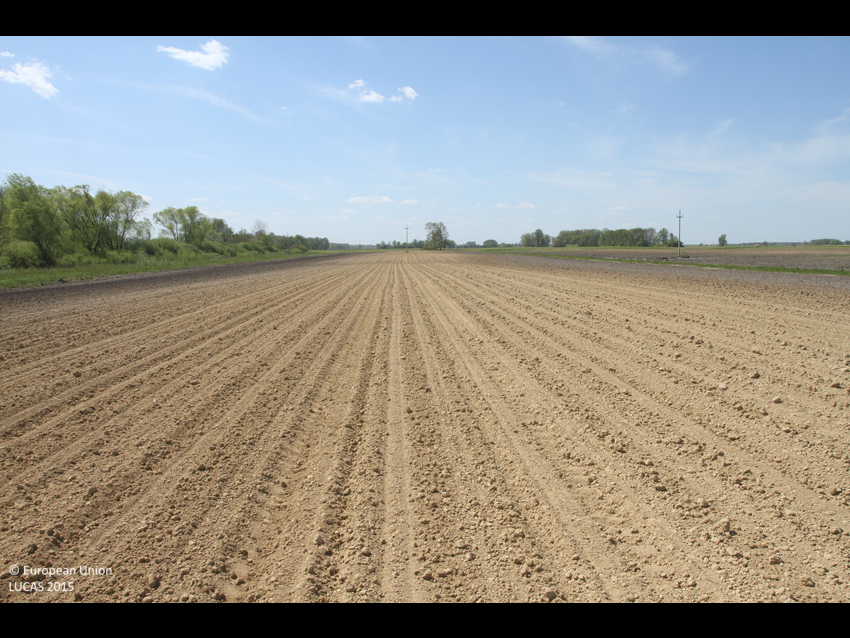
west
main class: Cropland
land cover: Soya
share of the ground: < 10 %
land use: Agriculture (excluding fallow land and kitchen gardens)
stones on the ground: < 10 %
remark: Tilled/Sowed
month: April
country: HR
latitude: 44.8738
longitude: 18.9045
